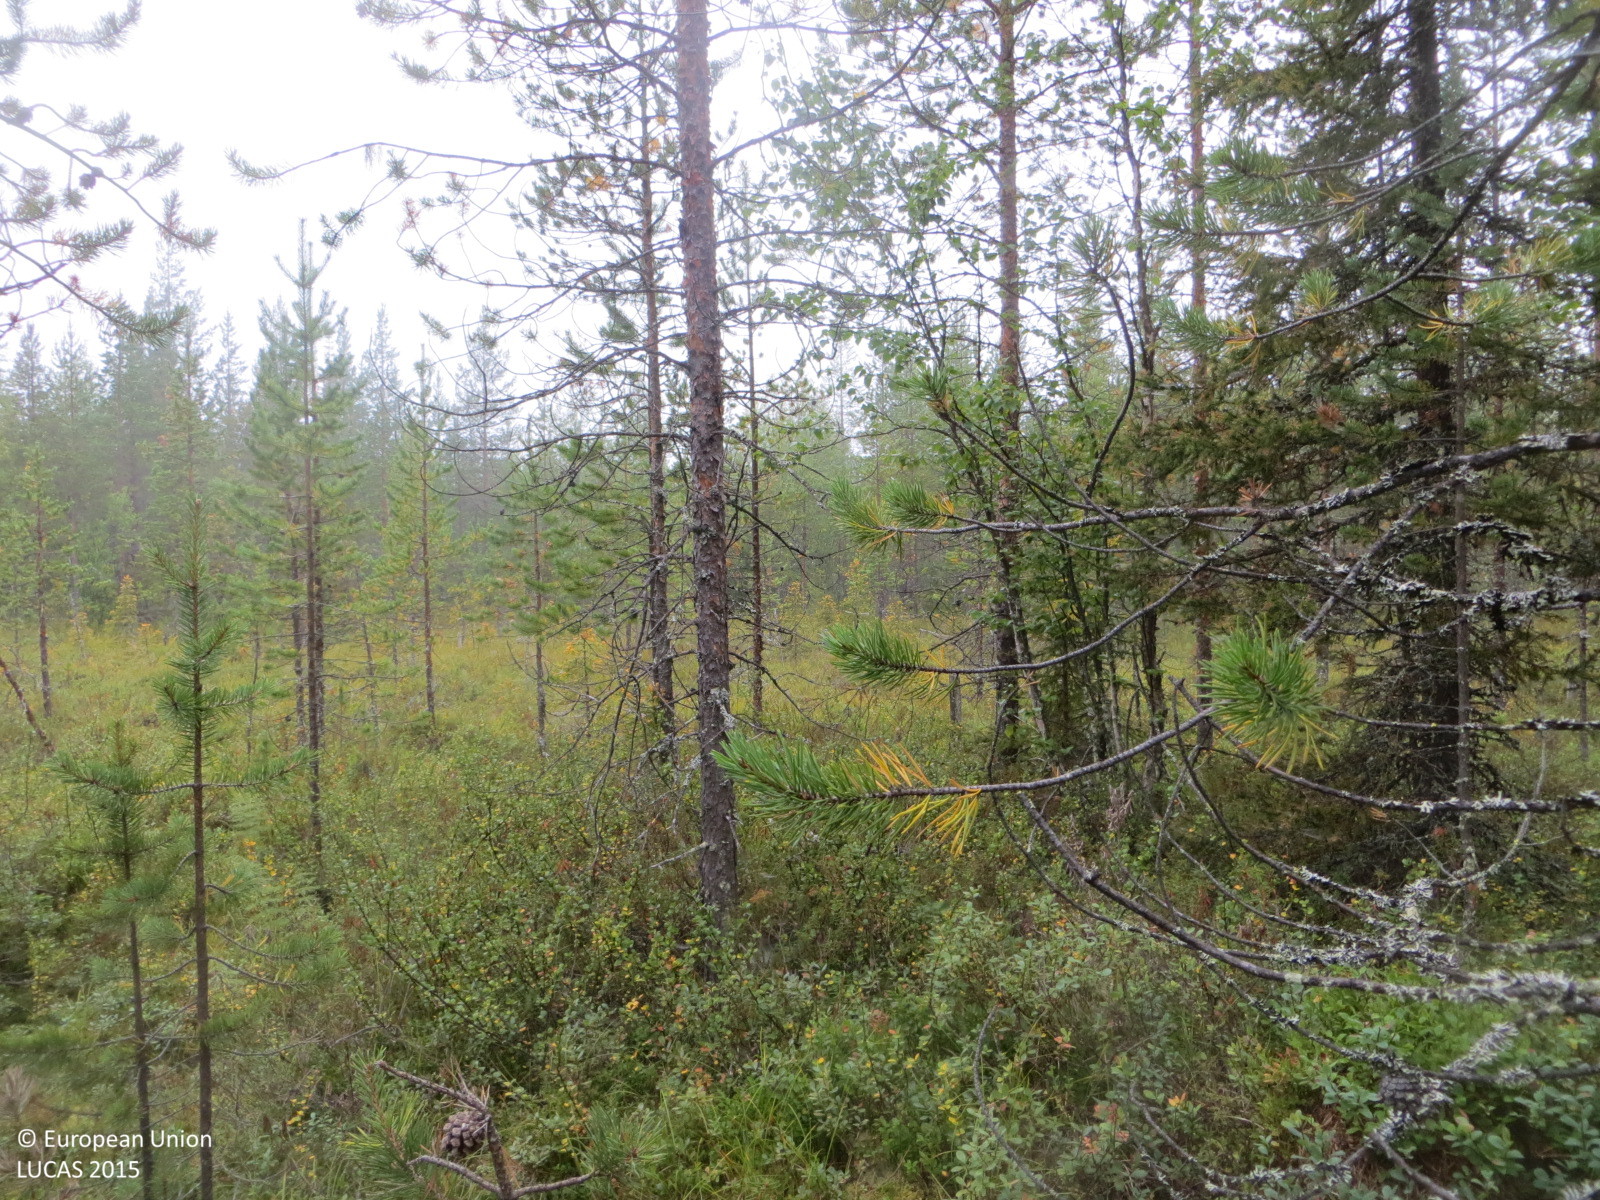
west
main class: Woodland
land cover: Pine dominated mixed woodland
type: mire and swamp forests
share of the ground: 50 - 75 %
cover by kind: coniferous forest trees 45 %, shrubs 30 %, broadleaved forest trees 25 %
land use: Forestry
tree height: > 5 m
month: August
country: FI
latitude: 67.3572
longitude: 23.9198
